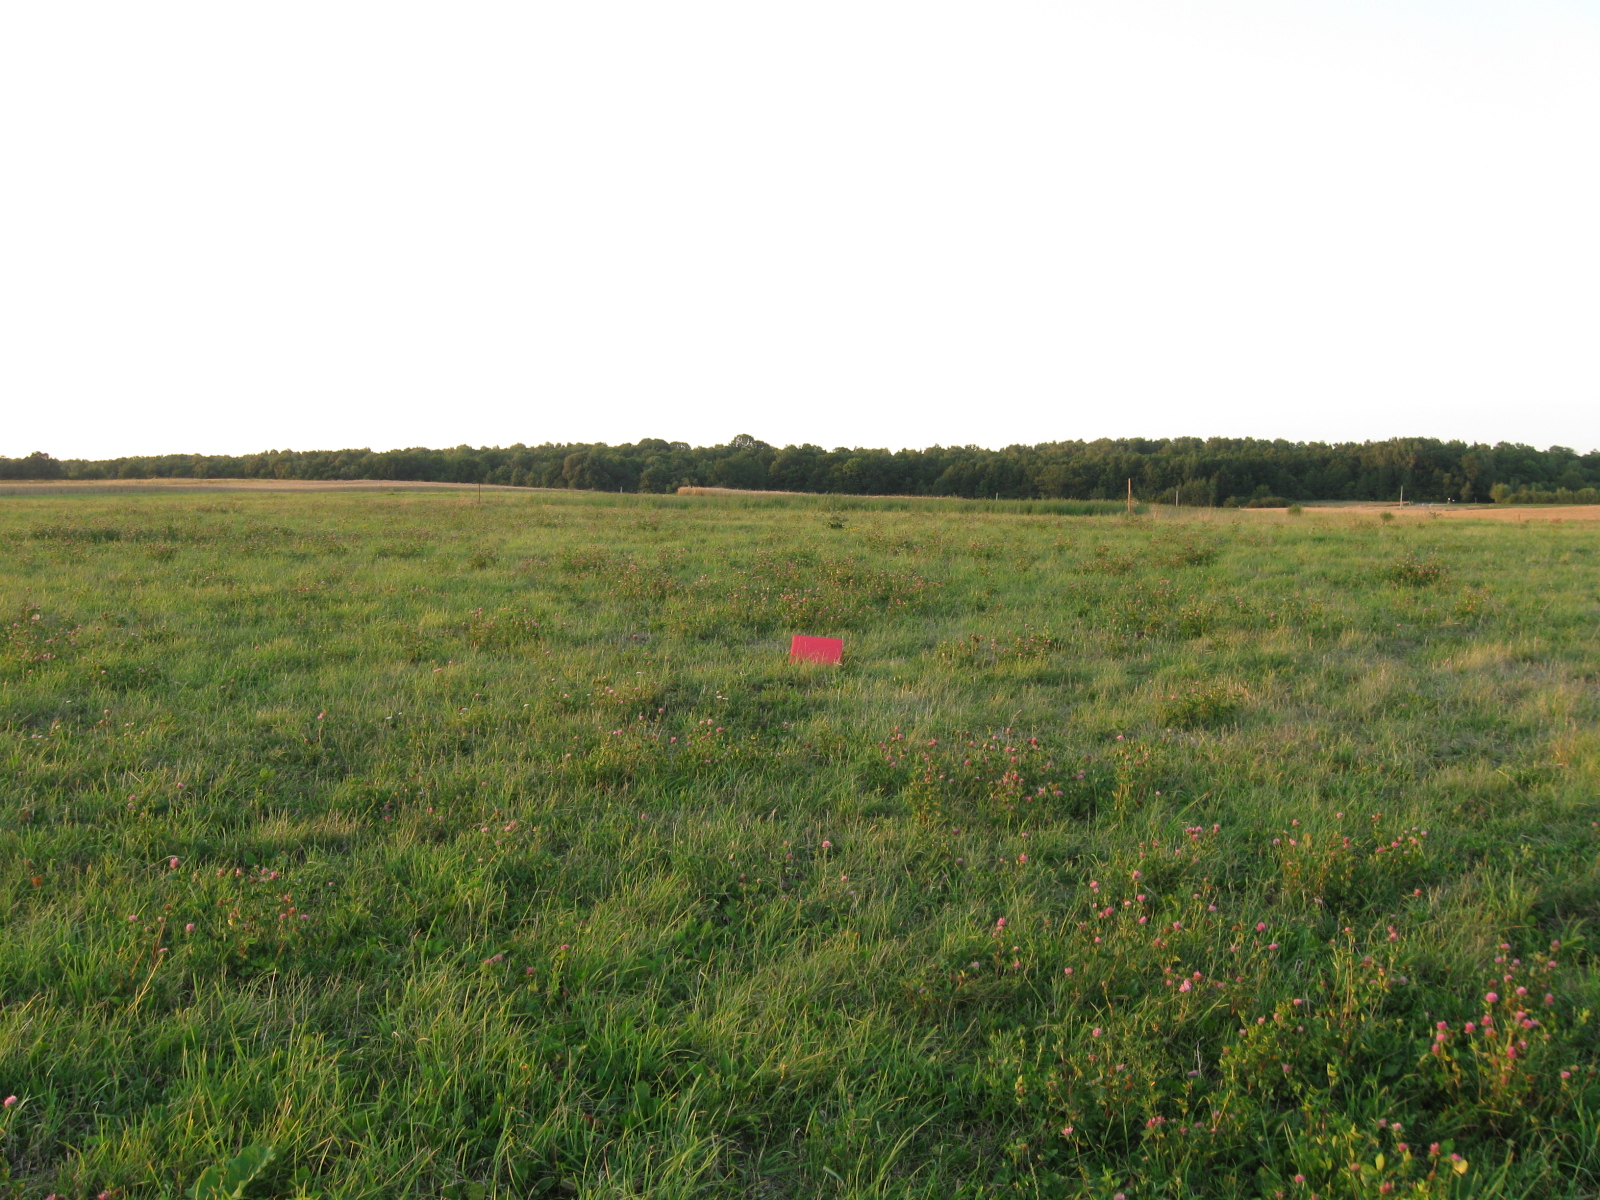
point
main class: Grassland
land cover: Grassland without tree/shrub cover
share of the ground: > 75 %
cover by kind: herbaceous plants 90 %, unconsolidated bare surface 10 %
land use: Agriculture (excluding fallow land and kitchen gardens)
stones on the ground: < 10 %
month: July
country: LT
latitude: 54.4209
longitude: 23.4114
